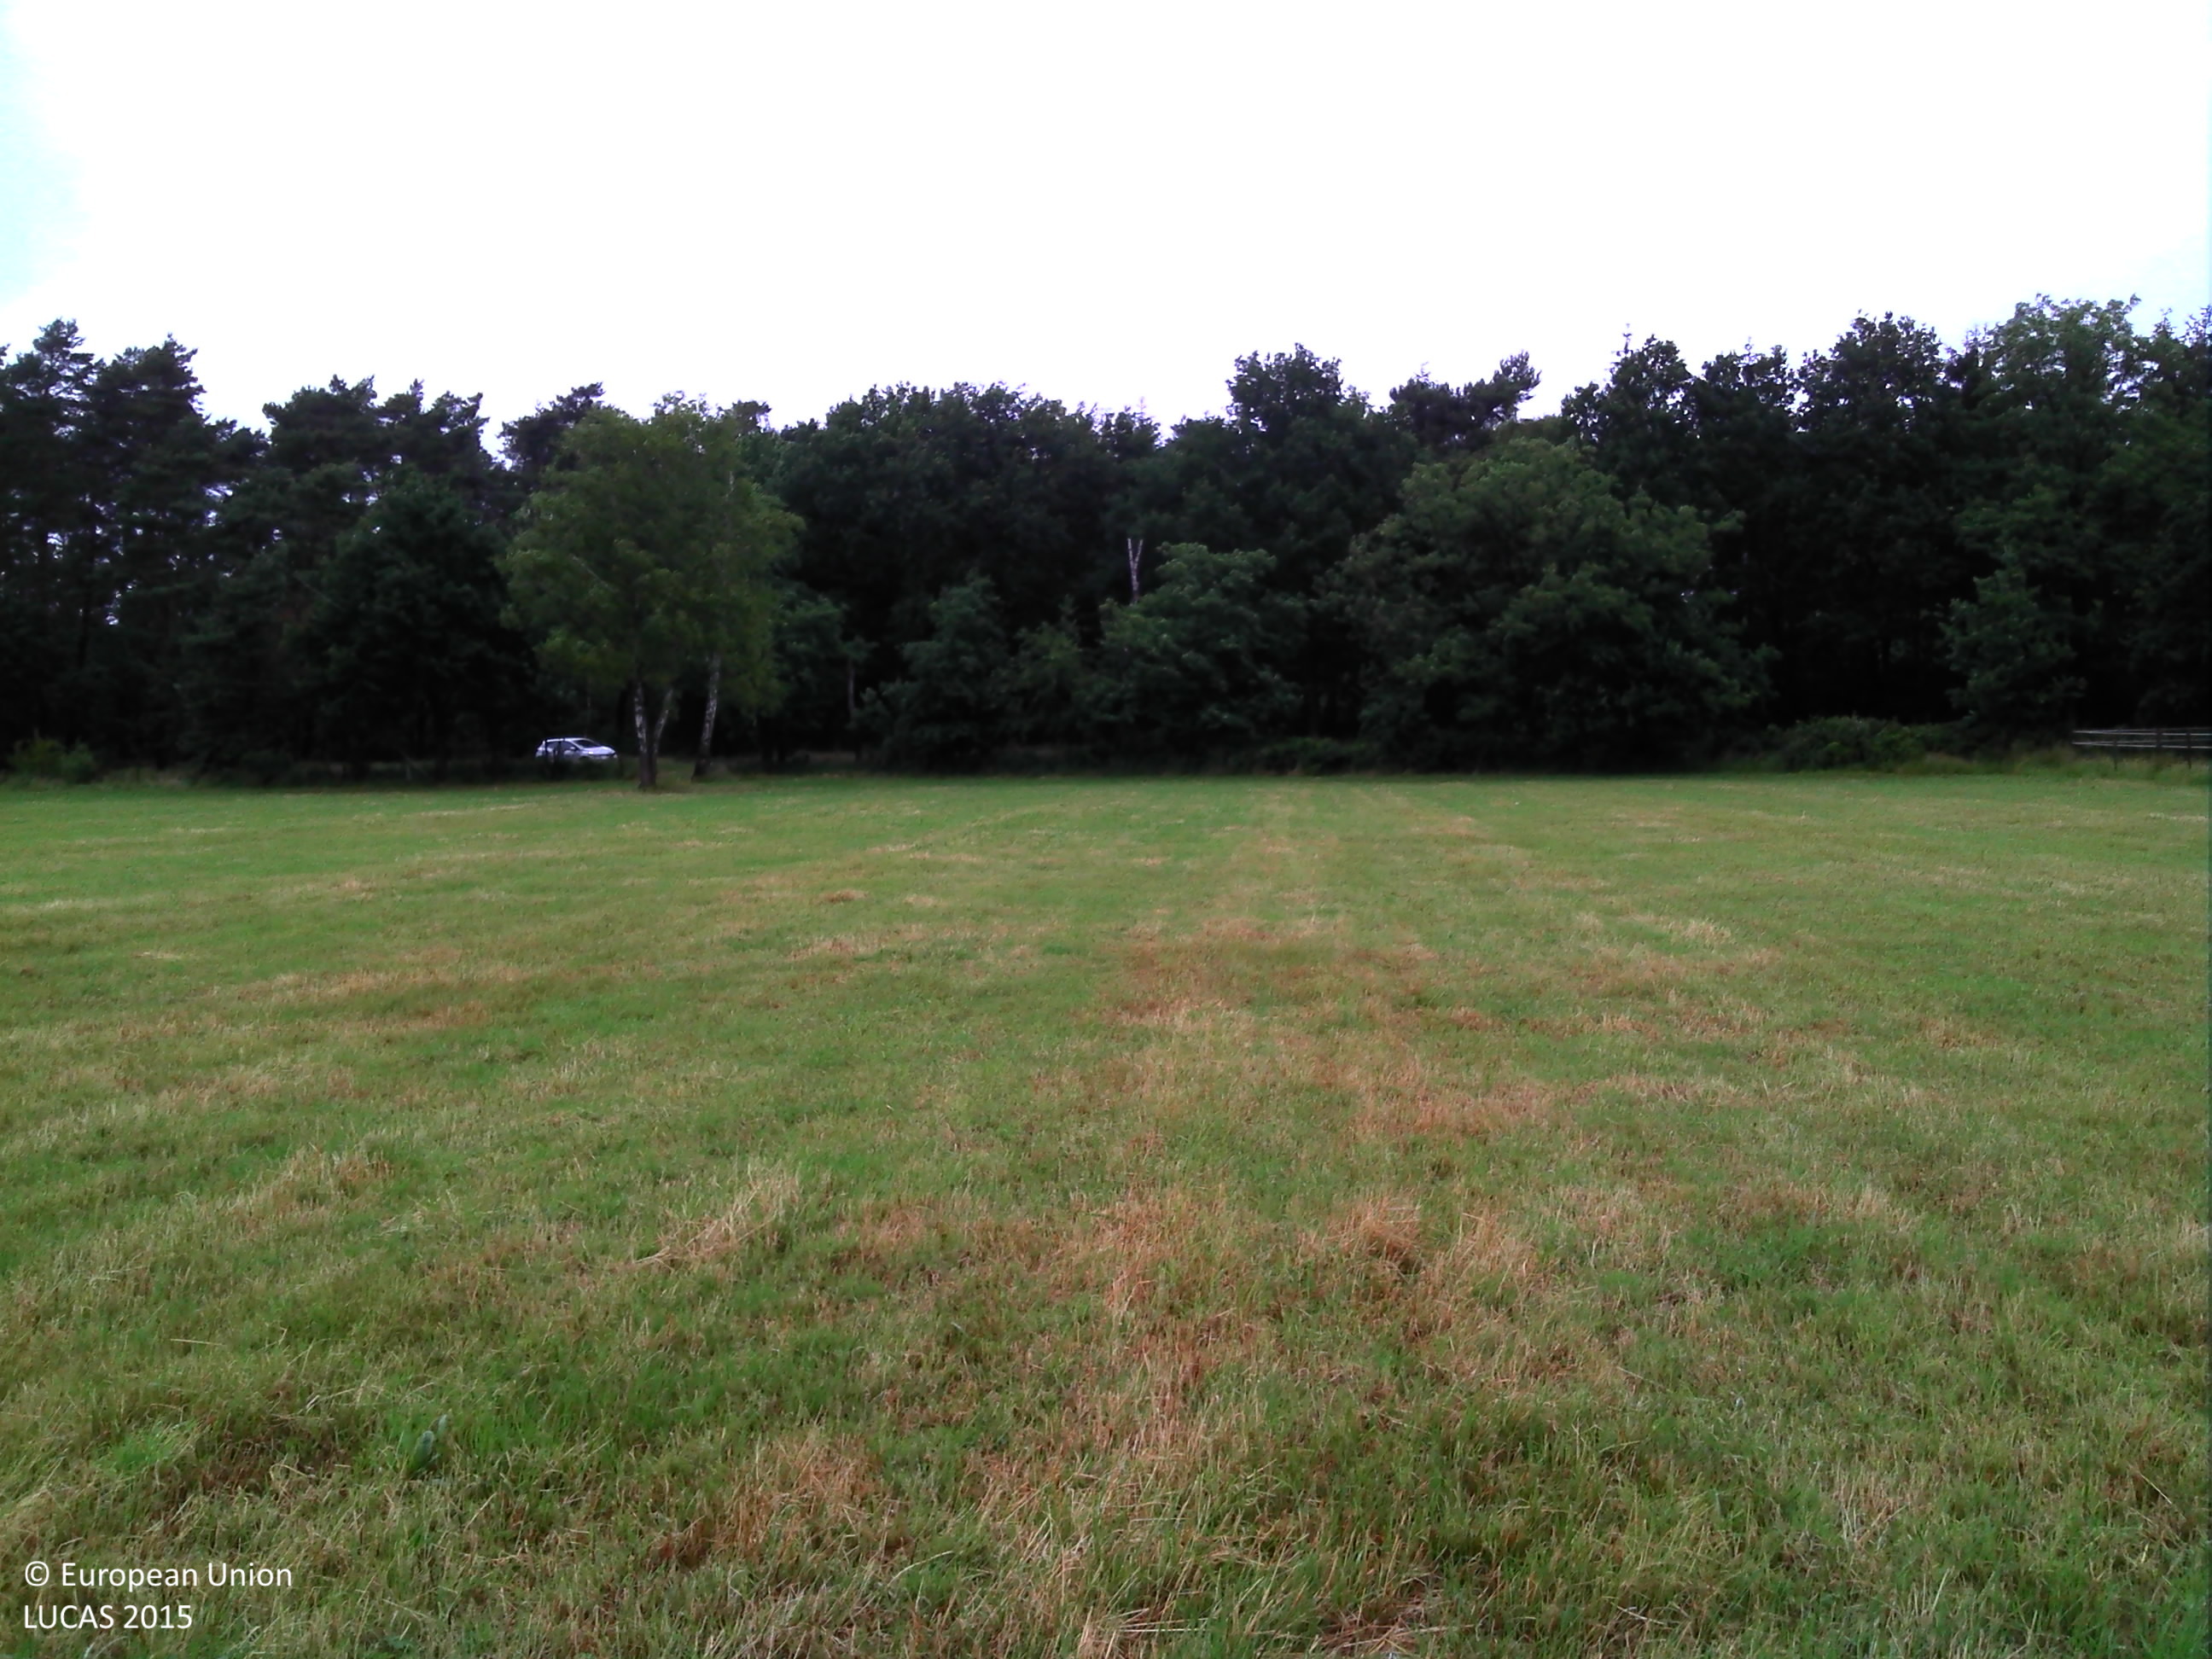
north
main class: Grassland
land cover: Grassland without tree/shrub cover
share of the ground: > 75 %
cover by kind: herbaceous plants 100 %
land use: Agriculture (excluding fallow land and kitchen gardens)
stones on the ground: < 10 %
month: June
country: BE
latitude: 51.0937
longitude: 5.2429
